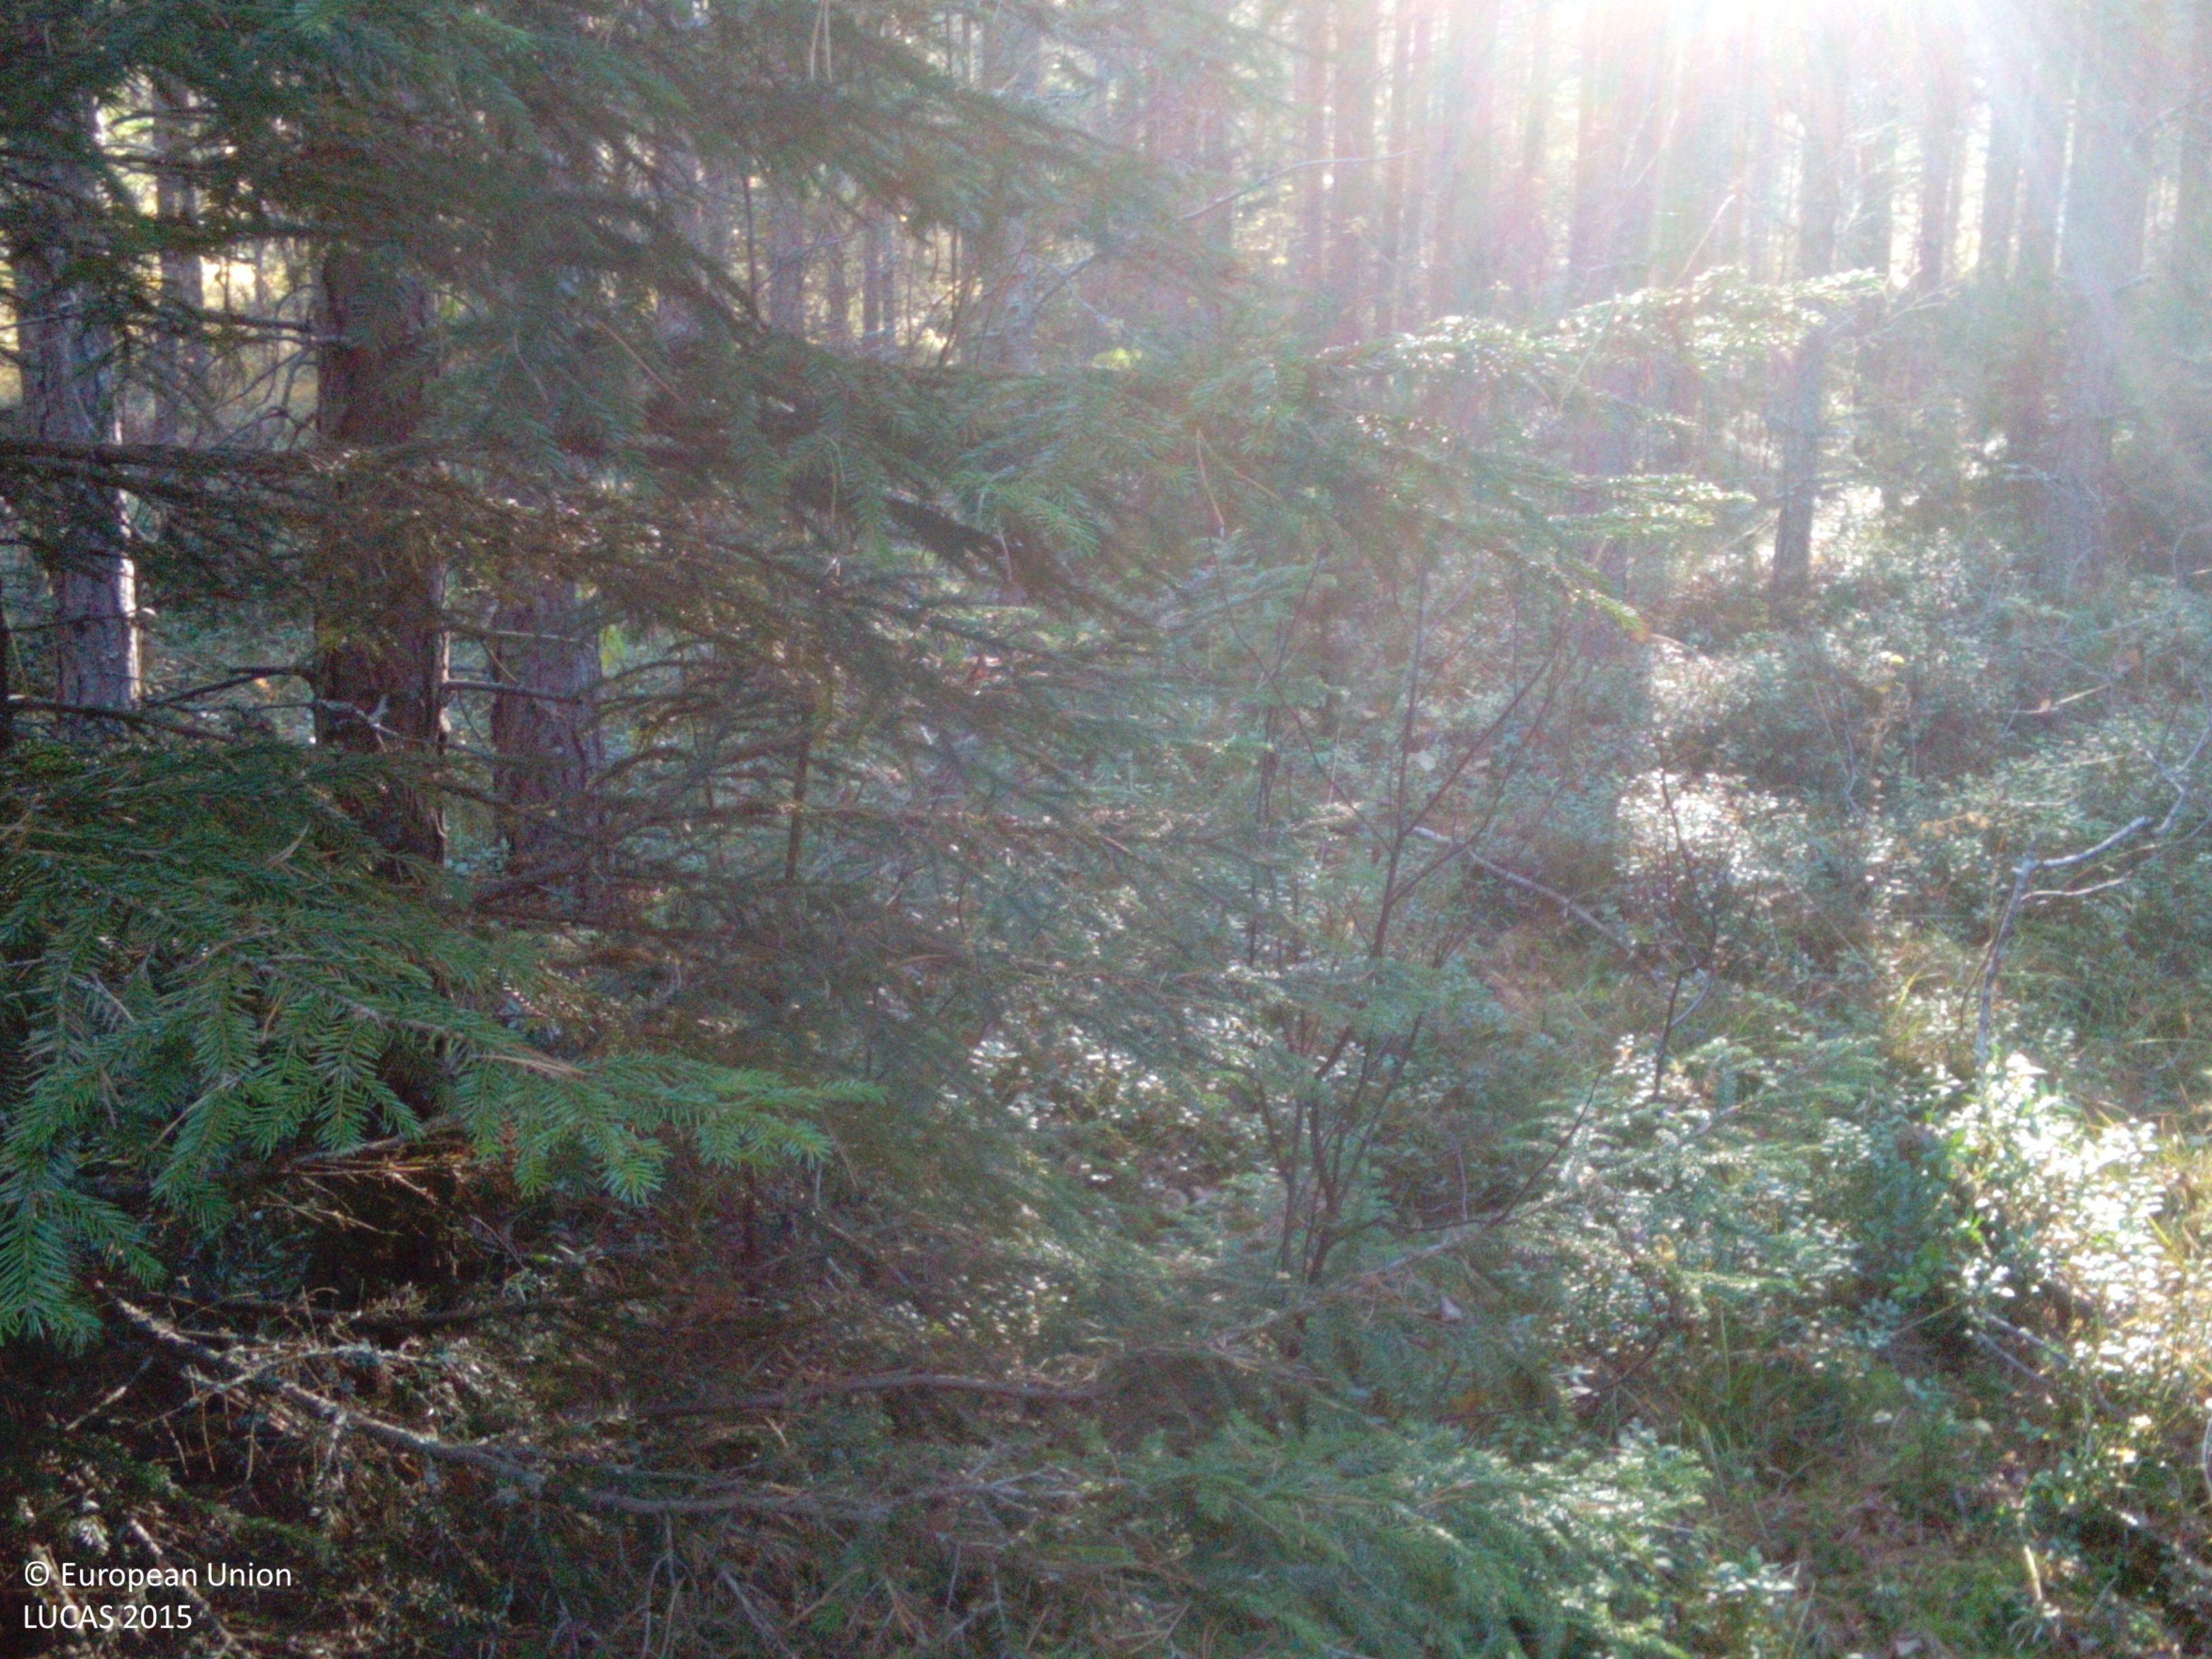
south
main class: Woodland
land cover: Other coniferous woodland
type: boreal forest
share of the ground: > 75 %
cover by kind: coniferous forest trees 85 %, herbaceous plants 10 %, lichens and mosses 5 %
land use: Forestry
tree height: > 5 m
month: October
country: SE
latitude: 59.2020
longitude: 16.4548
